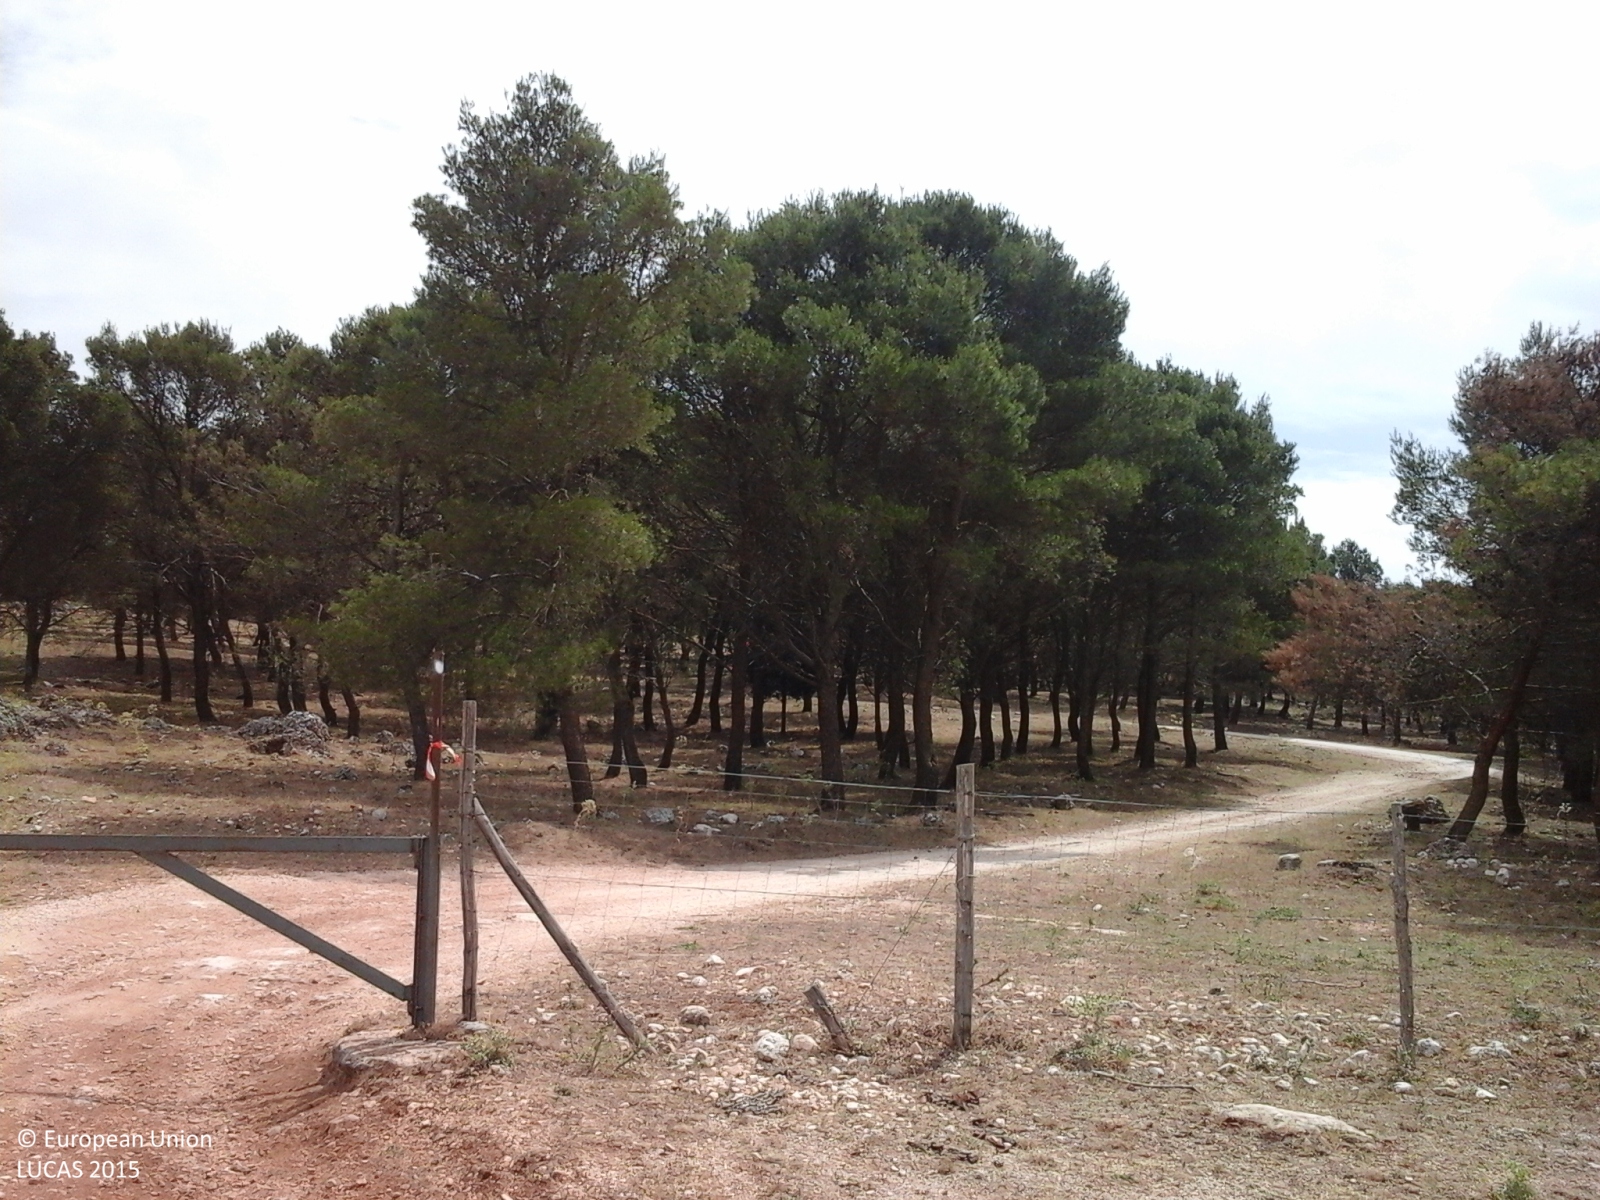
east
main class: Woodland
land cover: Pine dominated coniferous woodland
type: coniferous forest of the mediterranean region
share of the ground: > 75 %
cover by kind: coniferous forest trees 100 %
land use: Forestry
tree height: > 5 m
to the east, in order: Pine dominated coniferous woodland; Tracks; Pine dominated coniferous woodland; Tracks; Pine dominated coniferous woodland
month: June
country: IT
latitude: 37.6231
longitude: 13.1374
